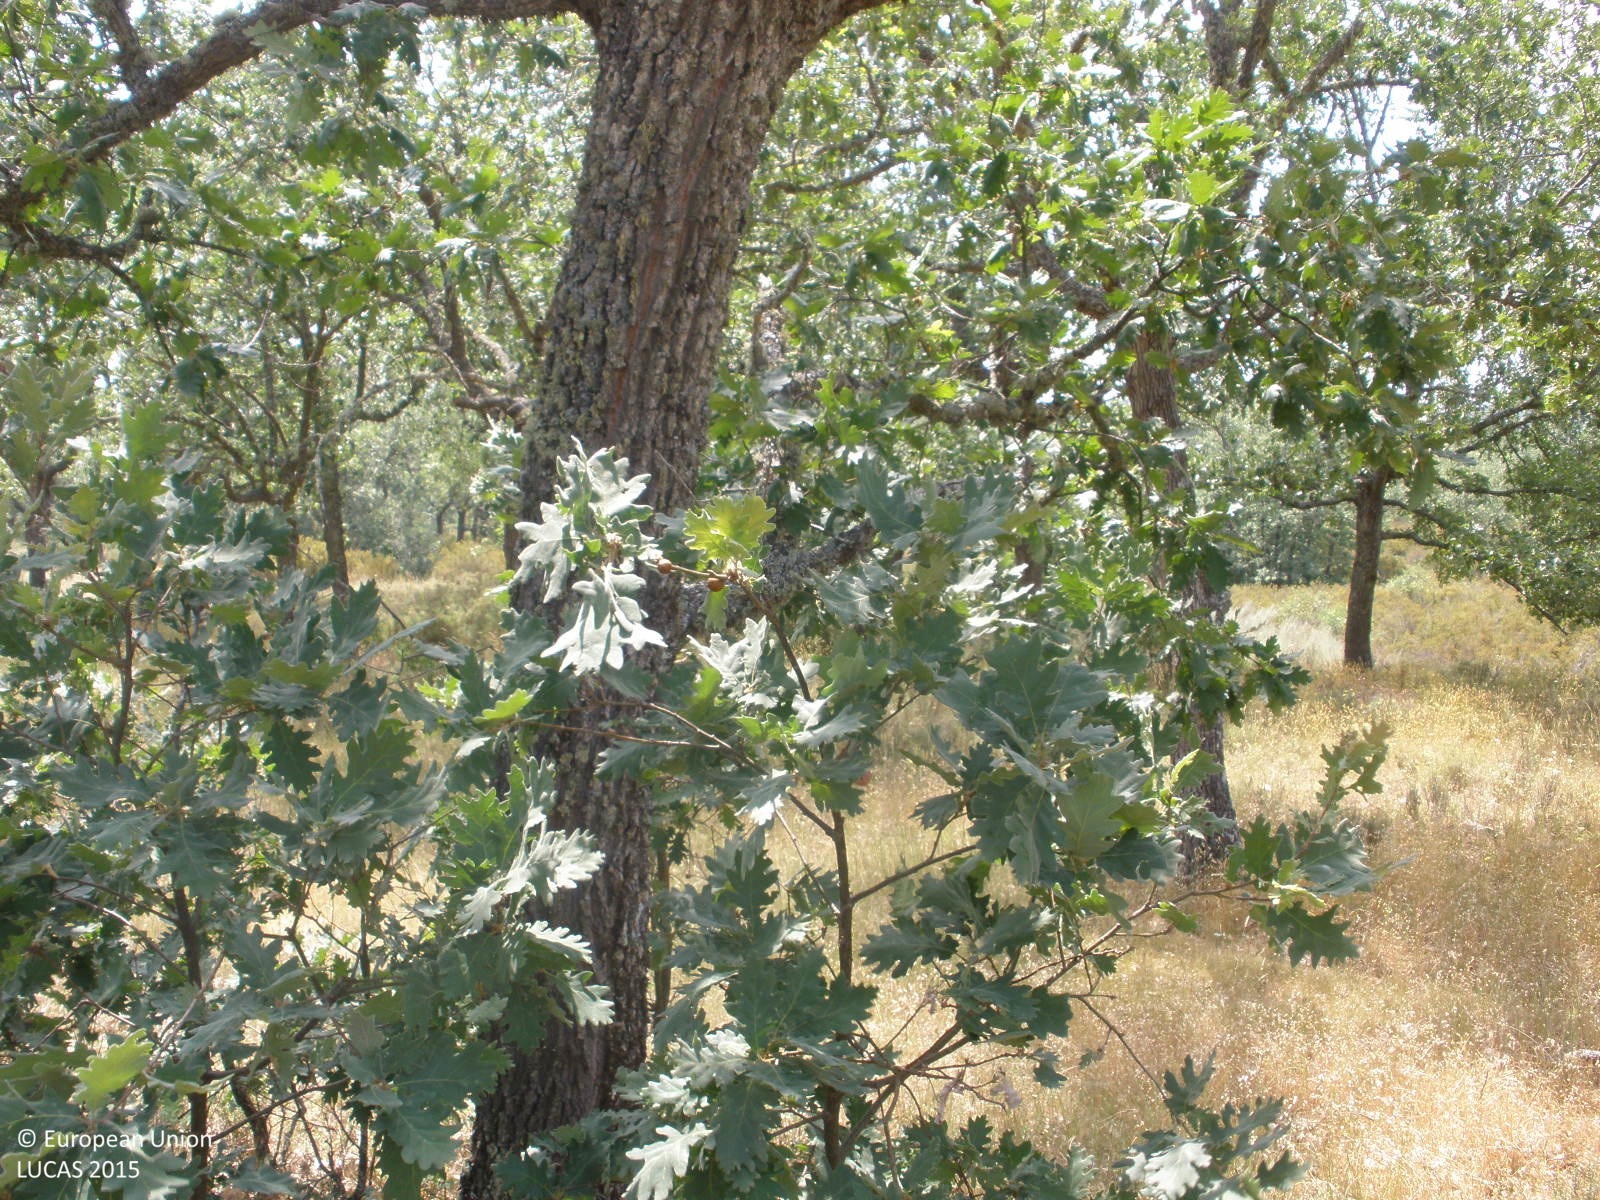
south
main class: Woodland
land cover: Broadleaved woodland
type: thermophilous deciduous forest
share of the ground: > 75 %
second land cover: Grassland without tree/shrub cover
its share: > 75 %
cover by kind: broadleaved forest trees 60 %, herbaceous plants 30 %, shrubs 10 %
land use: Forestry
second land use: Agriculture (excluding fallow land and kitchen gardens)
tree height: > 5 m
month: June
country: ES
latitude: 40.5863
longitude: -6.3066
